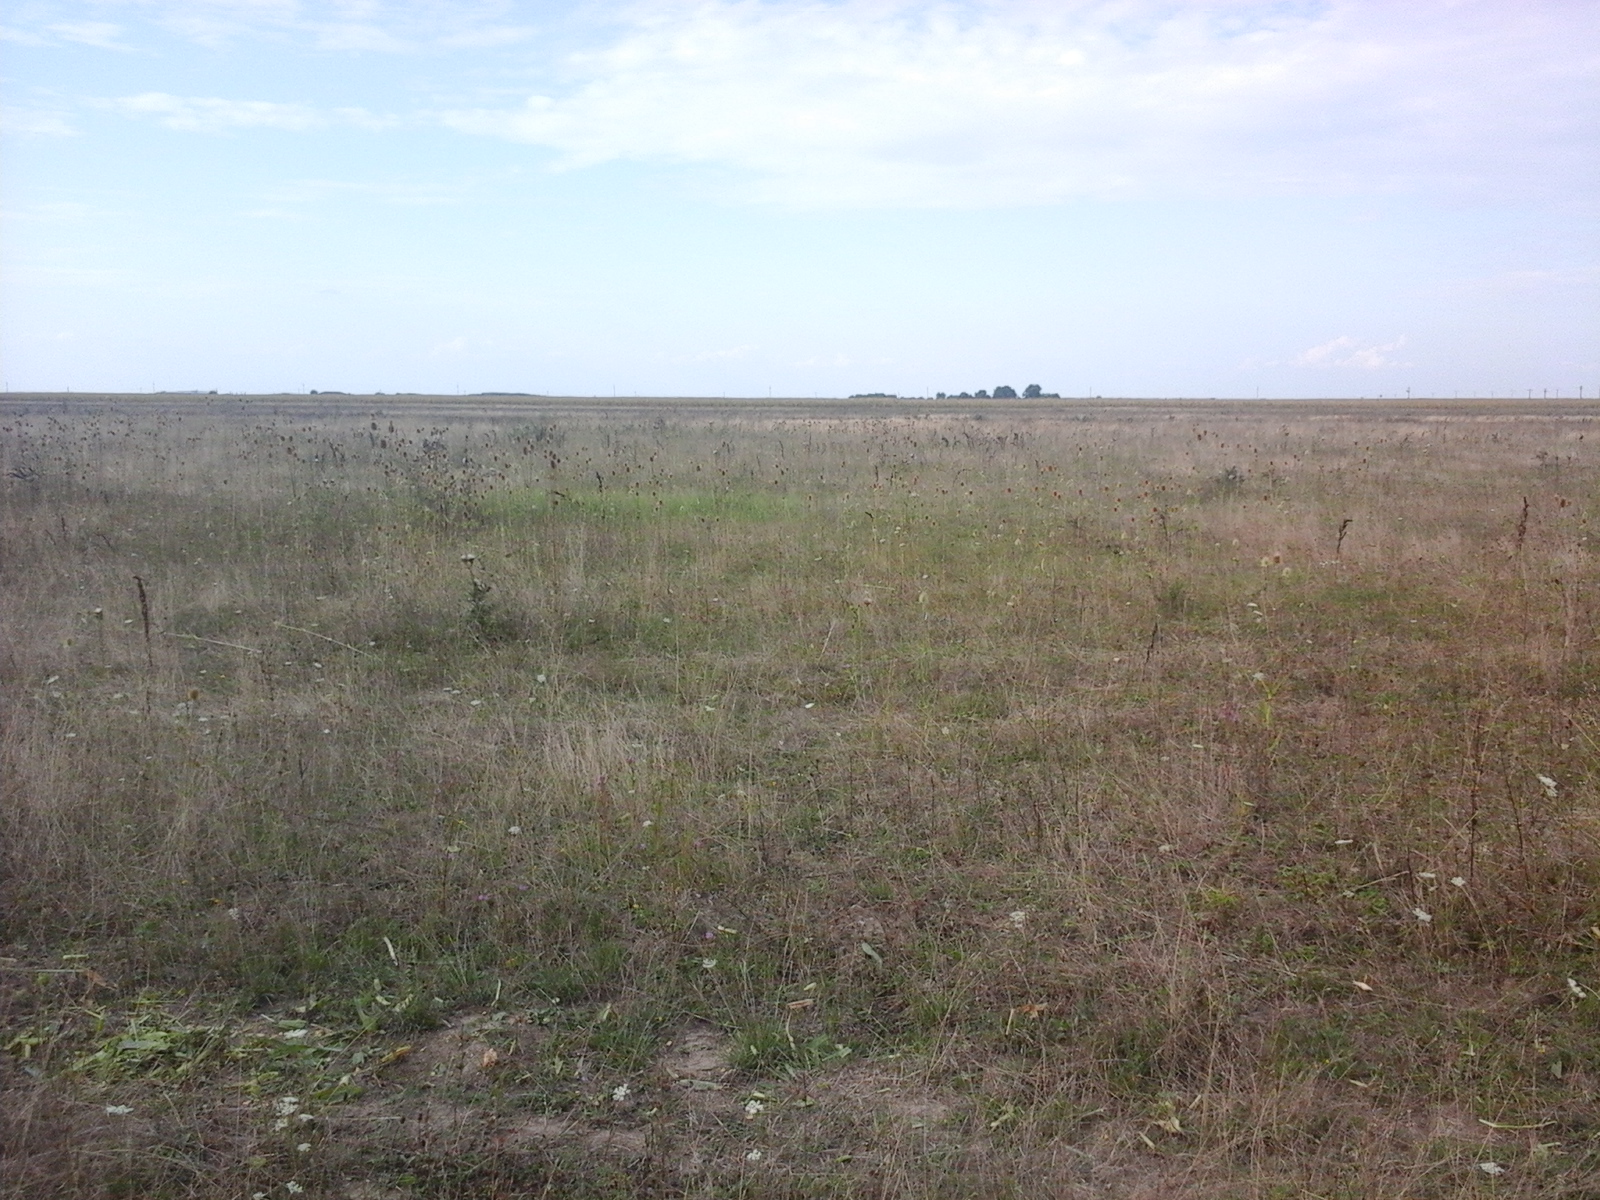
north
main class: Grassland
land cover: Spontaneously vegetated surfaces
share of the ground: > 75 %
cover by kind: herbaceous plants 100 %
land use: Fallow land
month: August
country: RO
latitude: 46.7160
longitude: 21.6181
